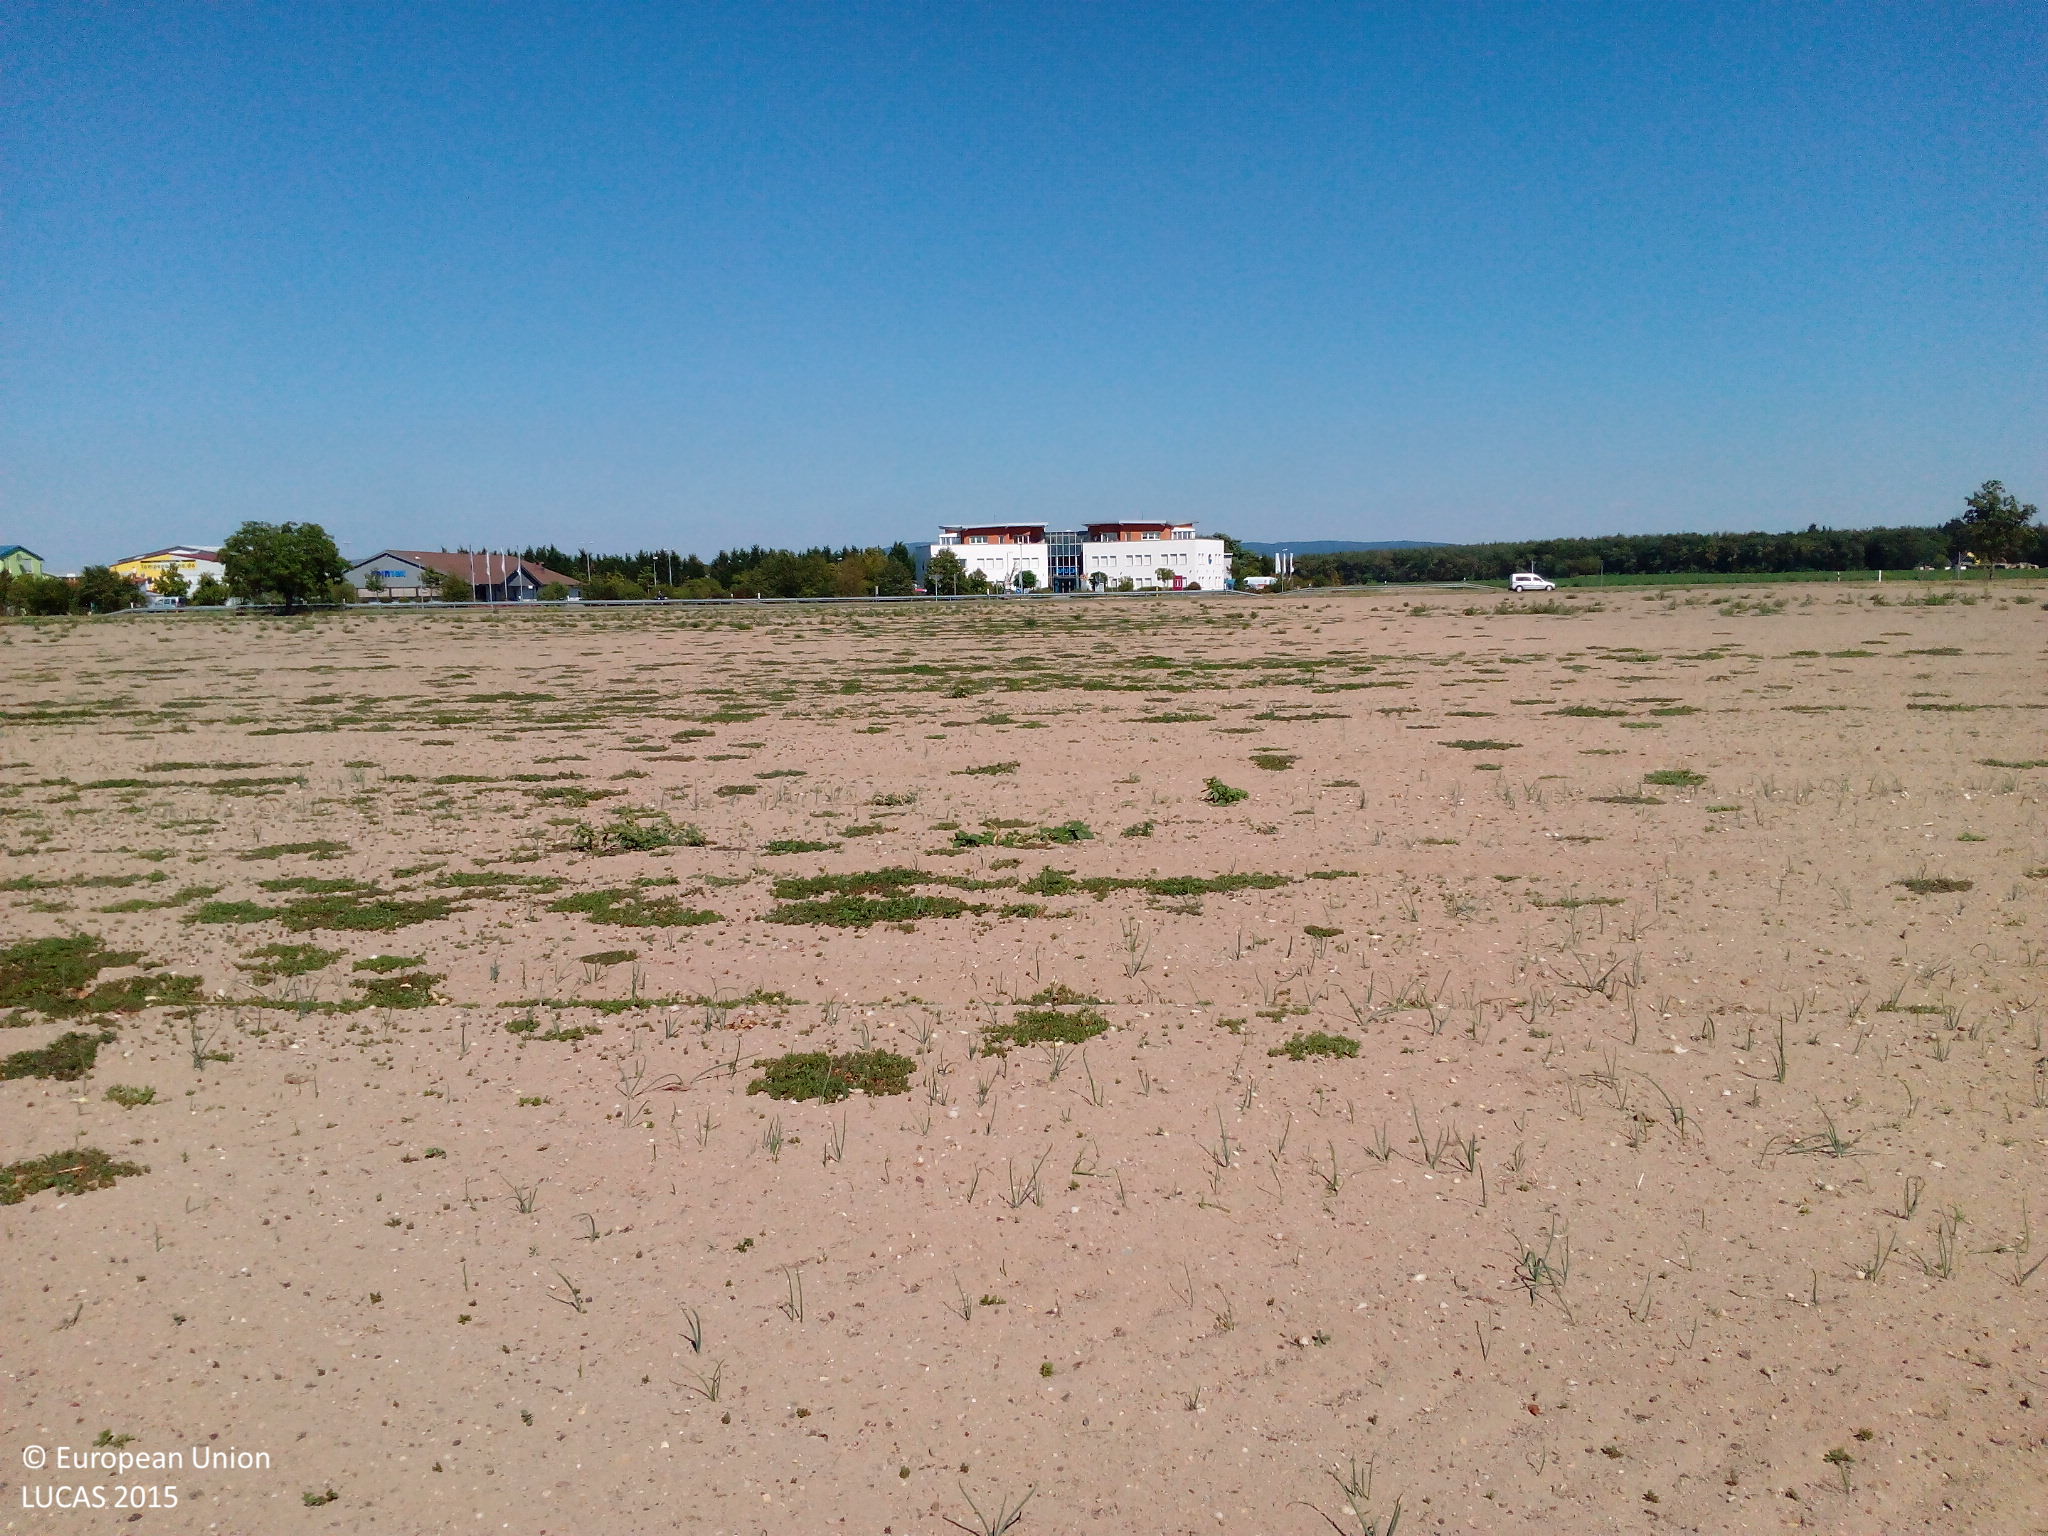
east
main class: Cropland
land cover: Other root crops
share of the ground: < 10 %
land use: Agriculture (excluding fallow land and kitchen gardens)
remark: Tilled/Sowed
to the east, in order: Other root crops; Grass margins; Paved roads, cycling and walking lanes; Grass margins; Paved roads, cycling and walking lanes; Grass margins; Paved roads, cycling and walking lanes; Grass margins; Other fresh vegetables
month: August
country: DE
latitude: 49.3473
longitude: 8.5276
